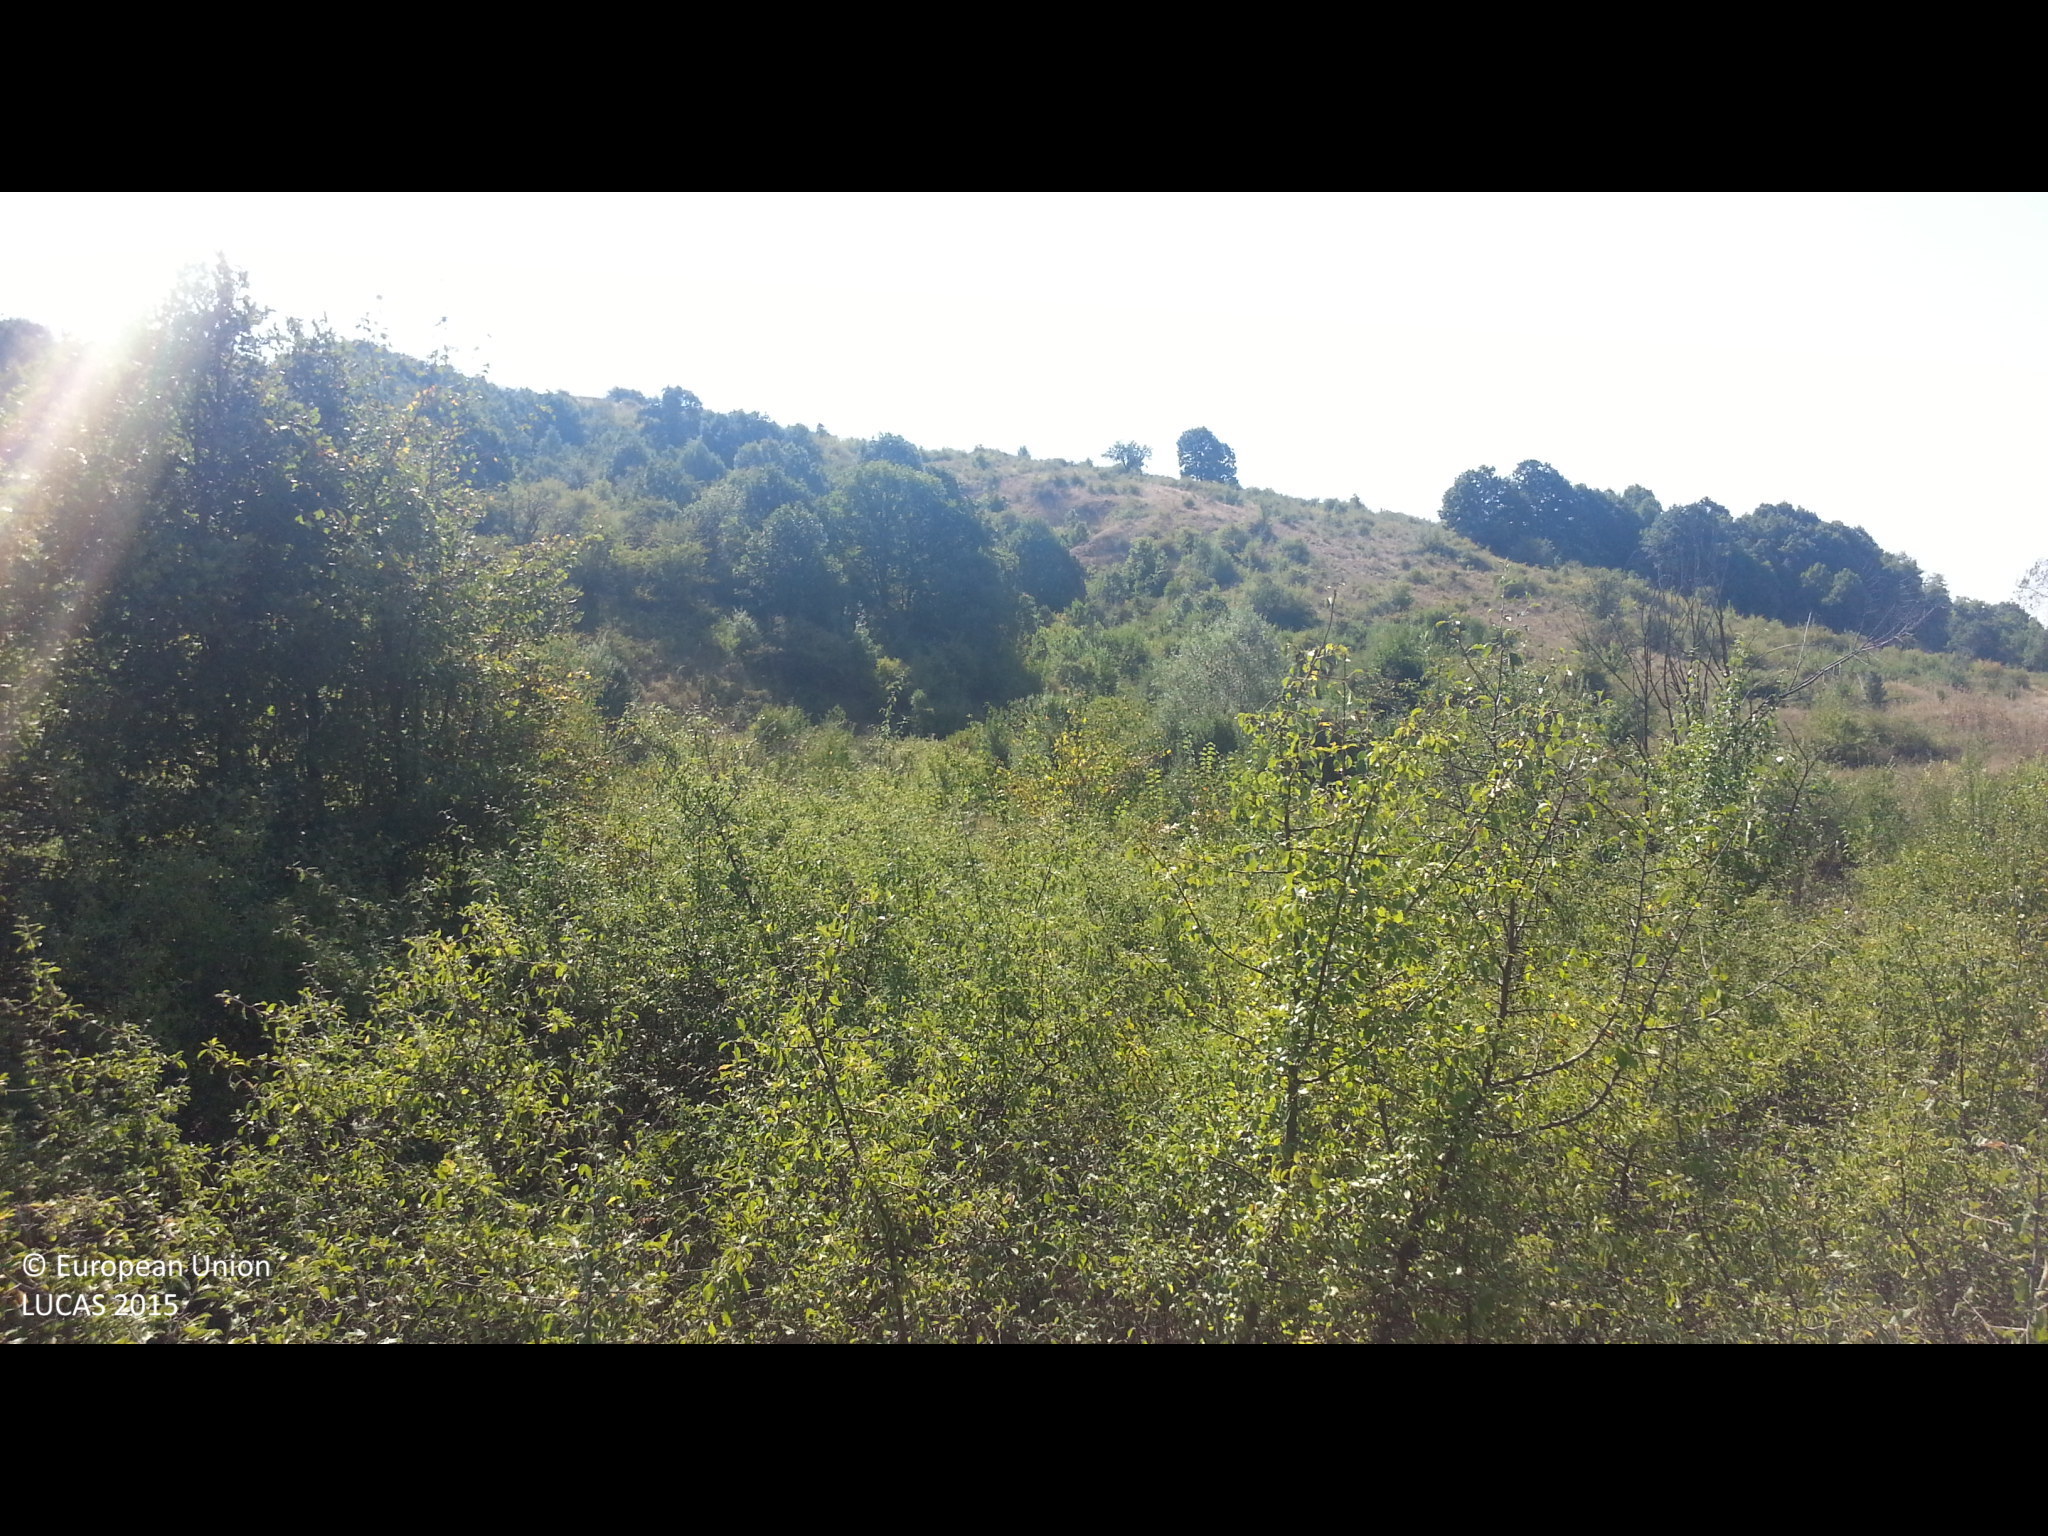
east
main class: Grassland
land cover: Grassland with sparse tree/shrub cover
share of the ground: > 75 %
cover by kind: herbaceous plants 95 %, broadleaved forest trees 5 %
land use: Semi-natural and natural areas not in use
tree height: < 5 m
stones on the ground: < 10 %
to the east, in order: Grassland with sparse tree/shrub cover; Shrubland with sparse tree cover; Broadleaved woodland; Grassland with sparse tree/shrub cover; Broadleaved woodland
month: September
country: BG
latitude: 42.3805
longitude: 22.9856
